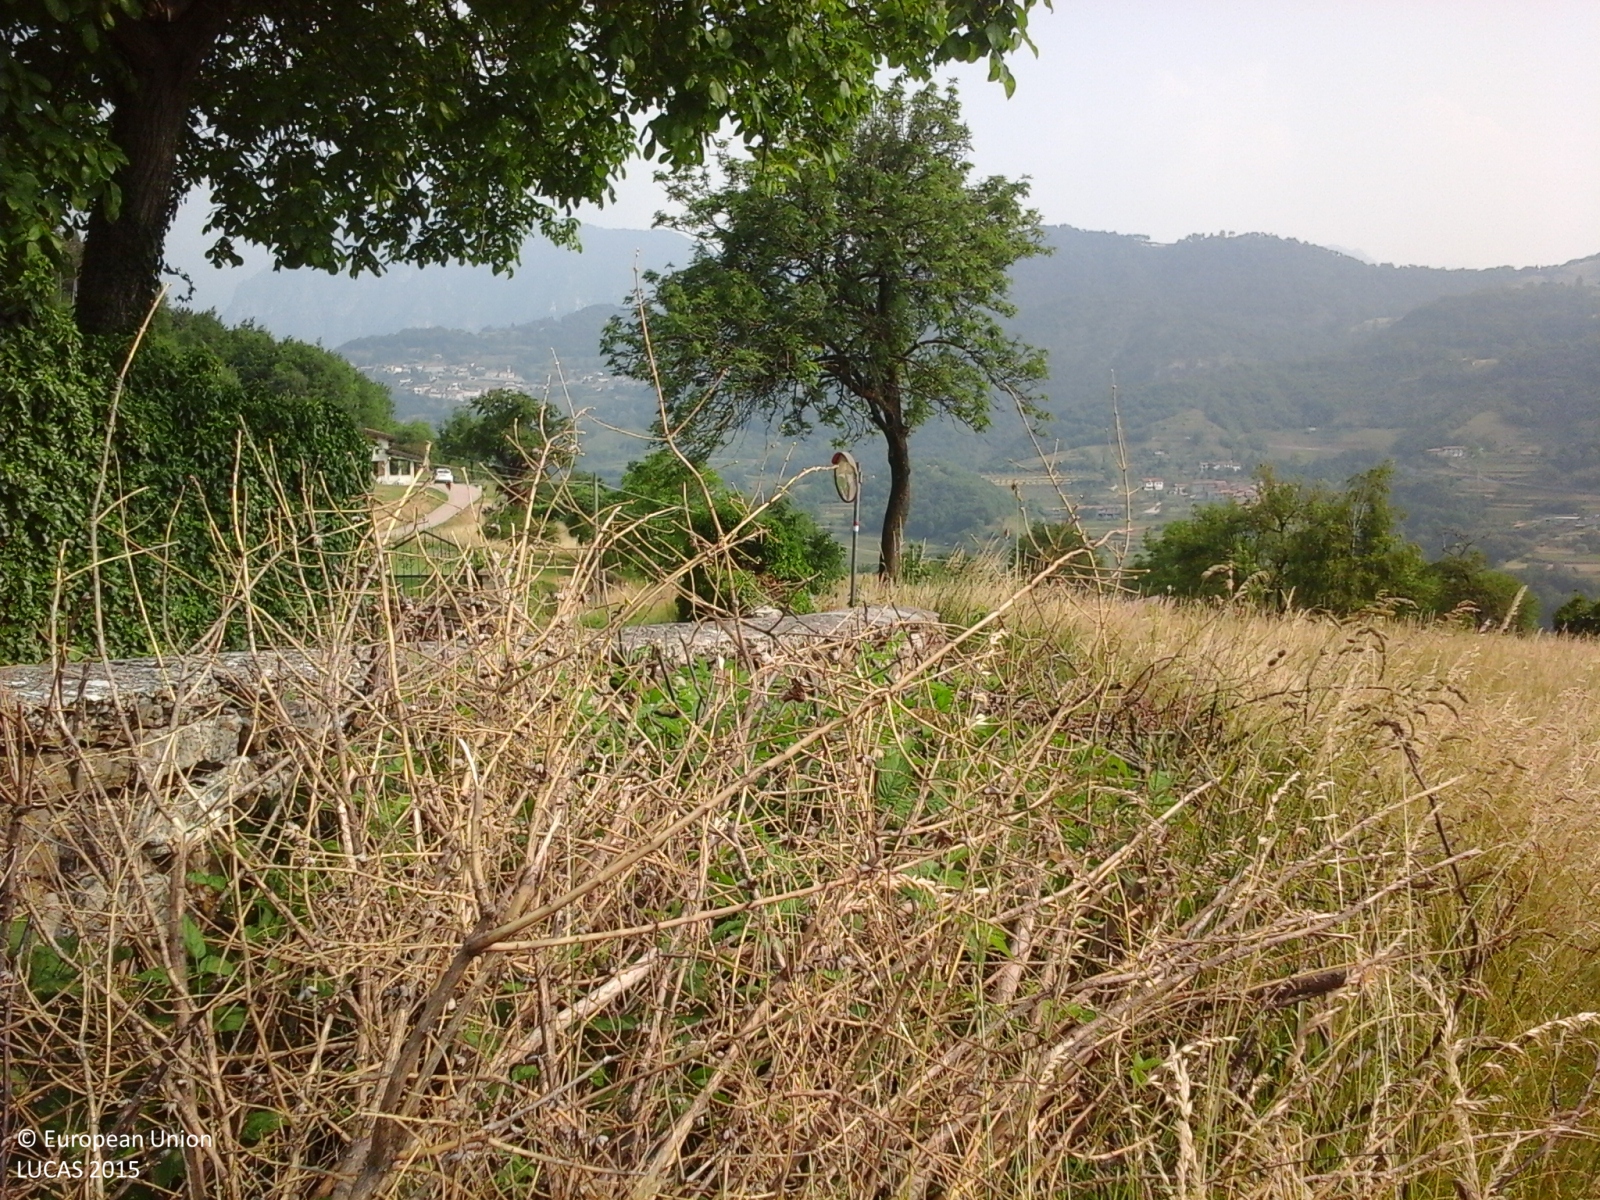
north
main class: Grassland
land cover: Grassland without tree/shrub cover
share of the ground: > 75 %
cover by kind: herbaceous plants 100 %
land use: Agriculture (excluding fallow land and kitchen gardens)
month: June
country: IT
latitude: 45.7542
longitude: 10.7316
